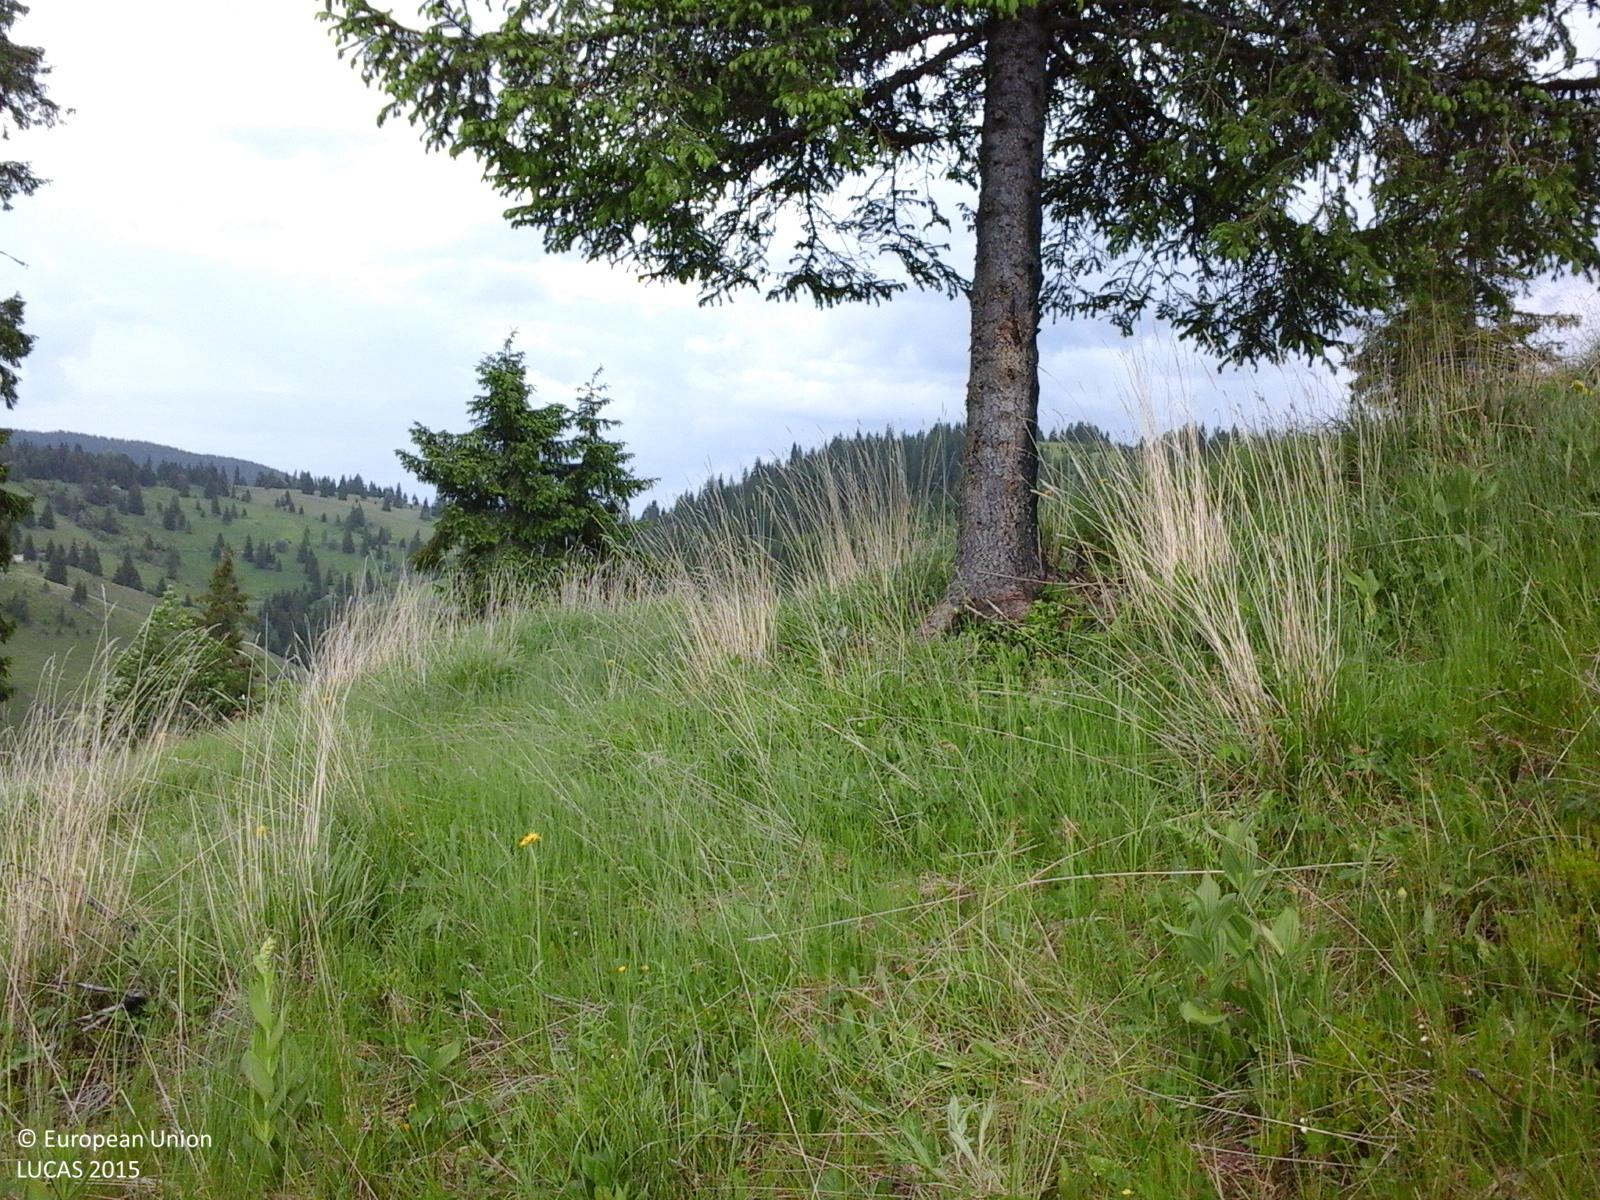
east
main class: Grassland
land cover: Grassland without tree/shrub cover
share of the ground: > 75 %
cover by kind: herbaceous plants 100 %
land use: Agriculture (excluding fallow land and kitchen gardens)
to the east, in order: Grassland without tree/shrub cover; Single bushes/trees; Grassland without tree/shrub cover; Fences; Lines of trees; Grassland without tree/shrub cover; Lines of trees; Grassland without tree/shrub cover; Fences; Grassland without tree/shrub cover
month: June
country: RO
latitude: 47.1831
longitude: 25.4331
